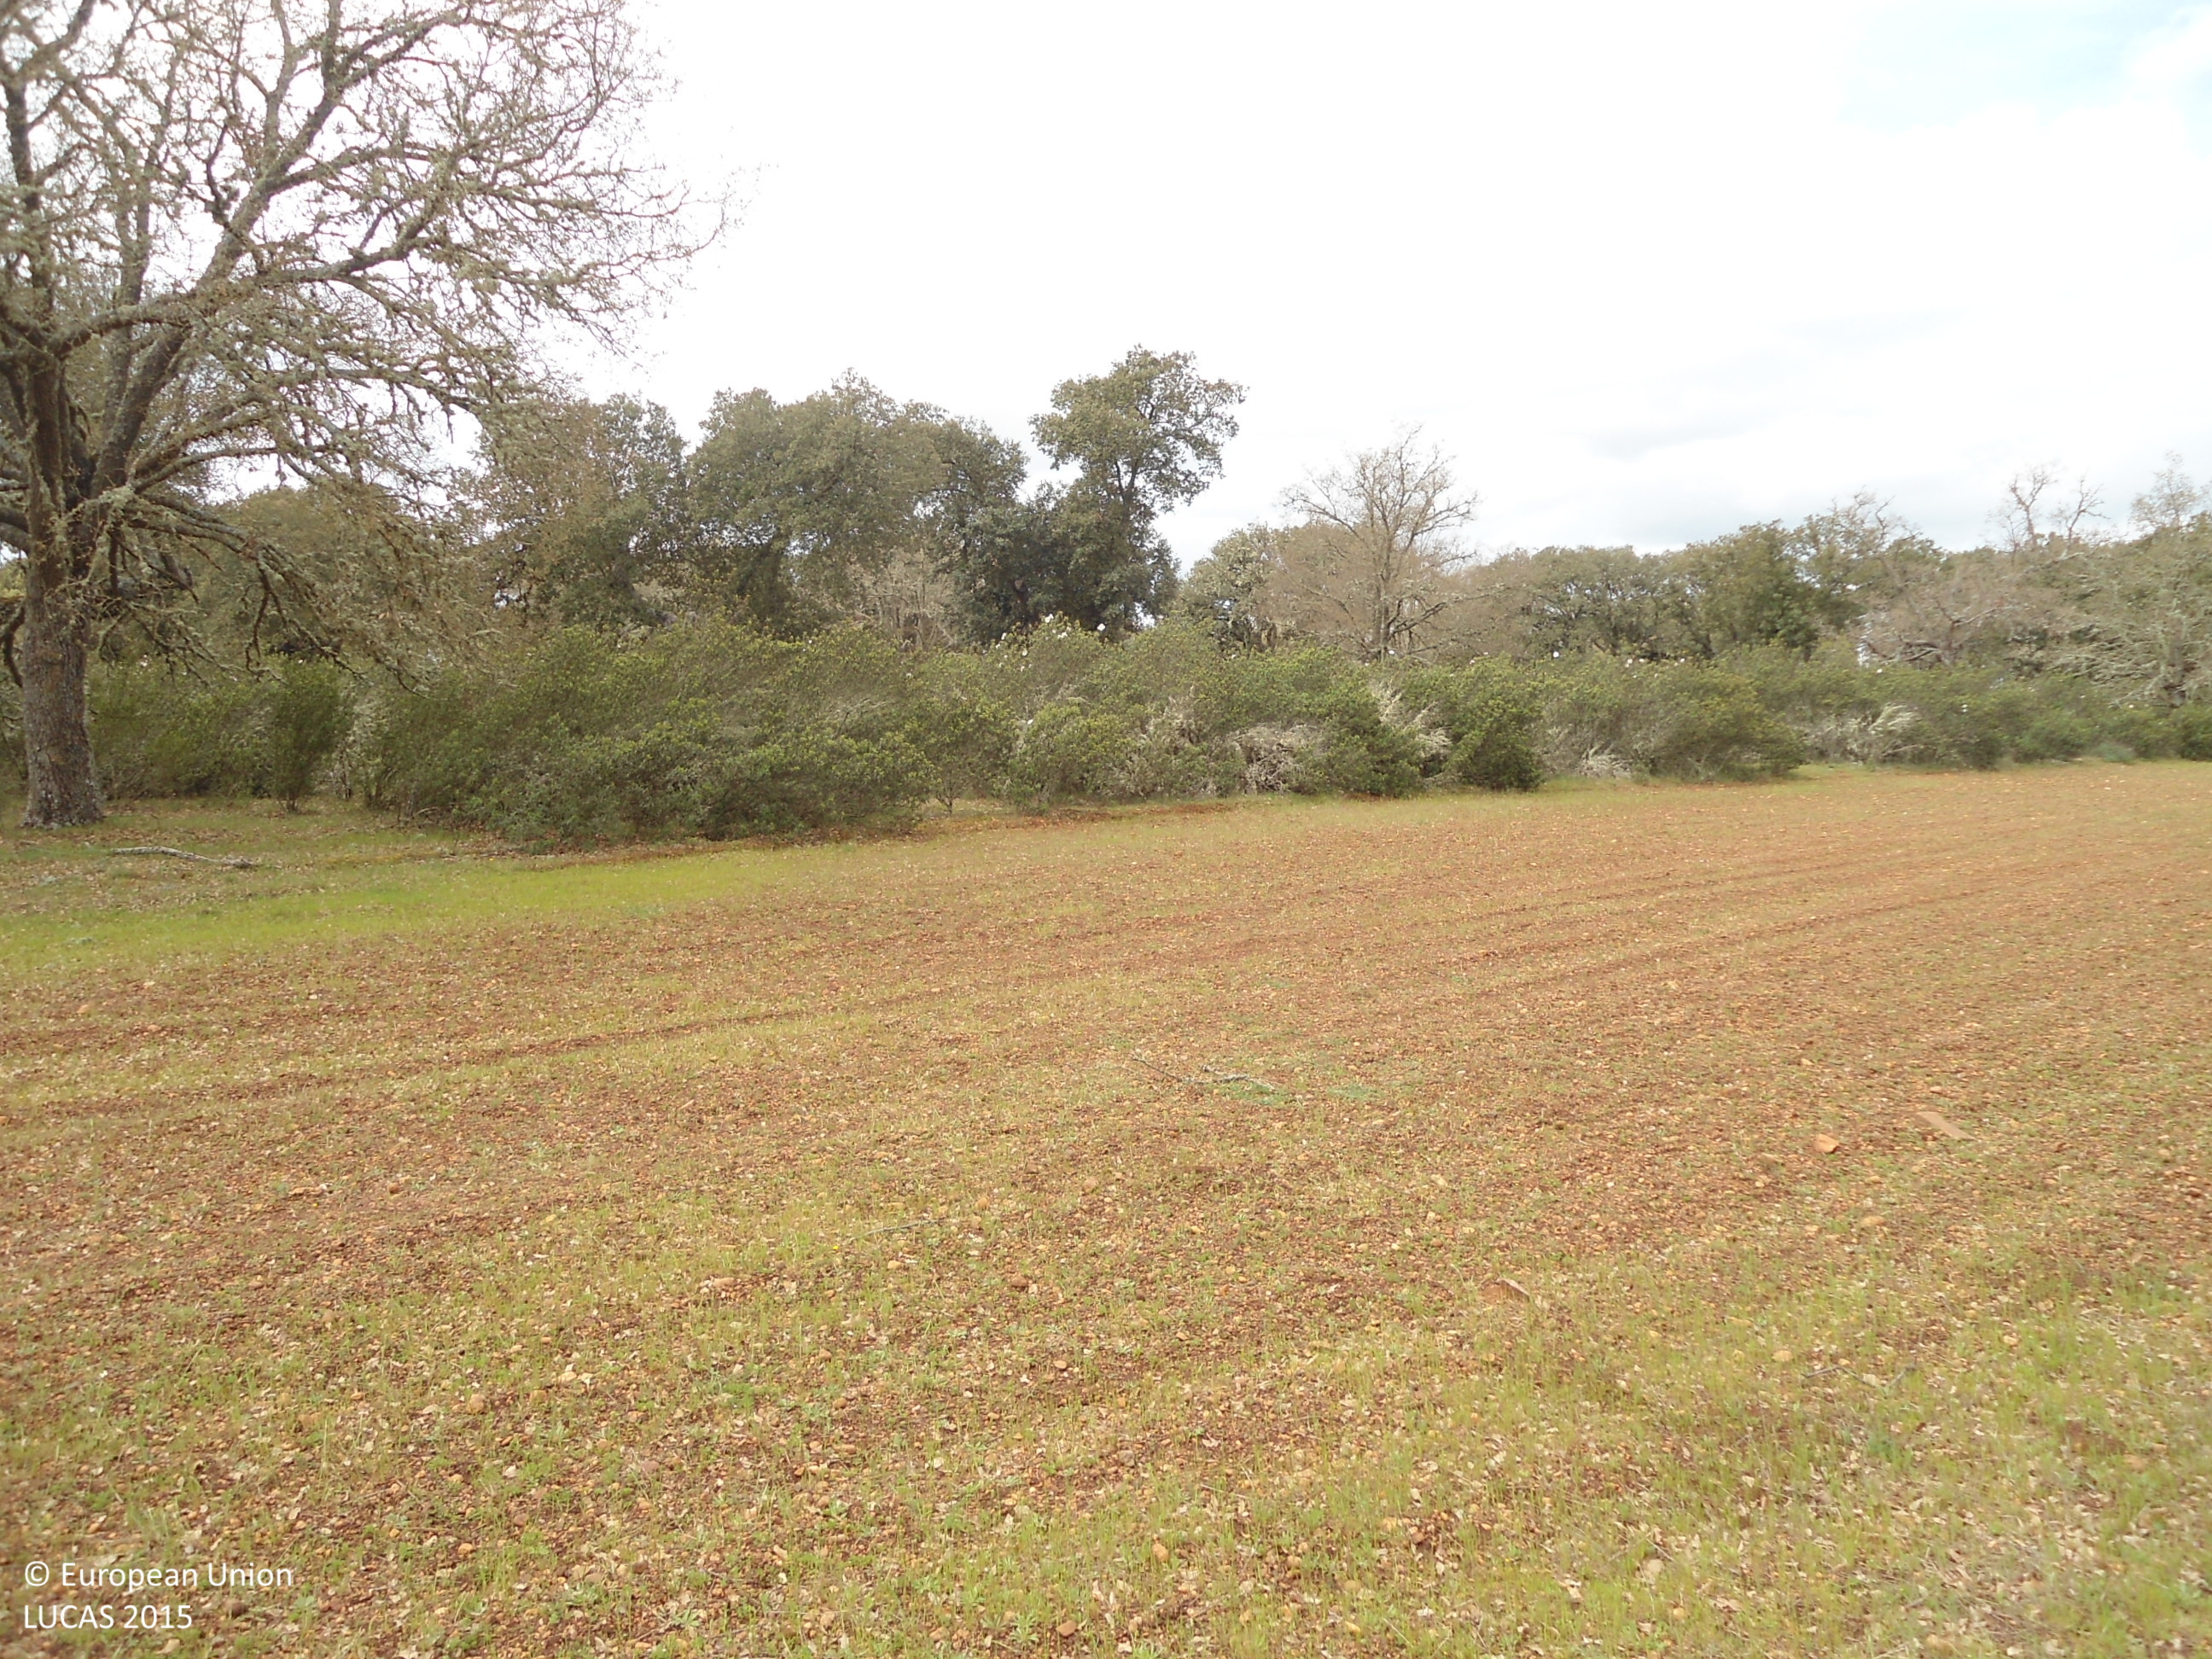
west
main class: Grassland
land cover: Spontaneously vegetated surfaces
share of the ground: > 75 %
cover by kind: herbaceous plants 90 %, shrubs 5 %, unconsolidated bare surface 5 %
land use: Agriculture (excluding fallow land and kitchen gardens)
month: April
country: ES
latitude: 41.6276
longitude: -5.8994
